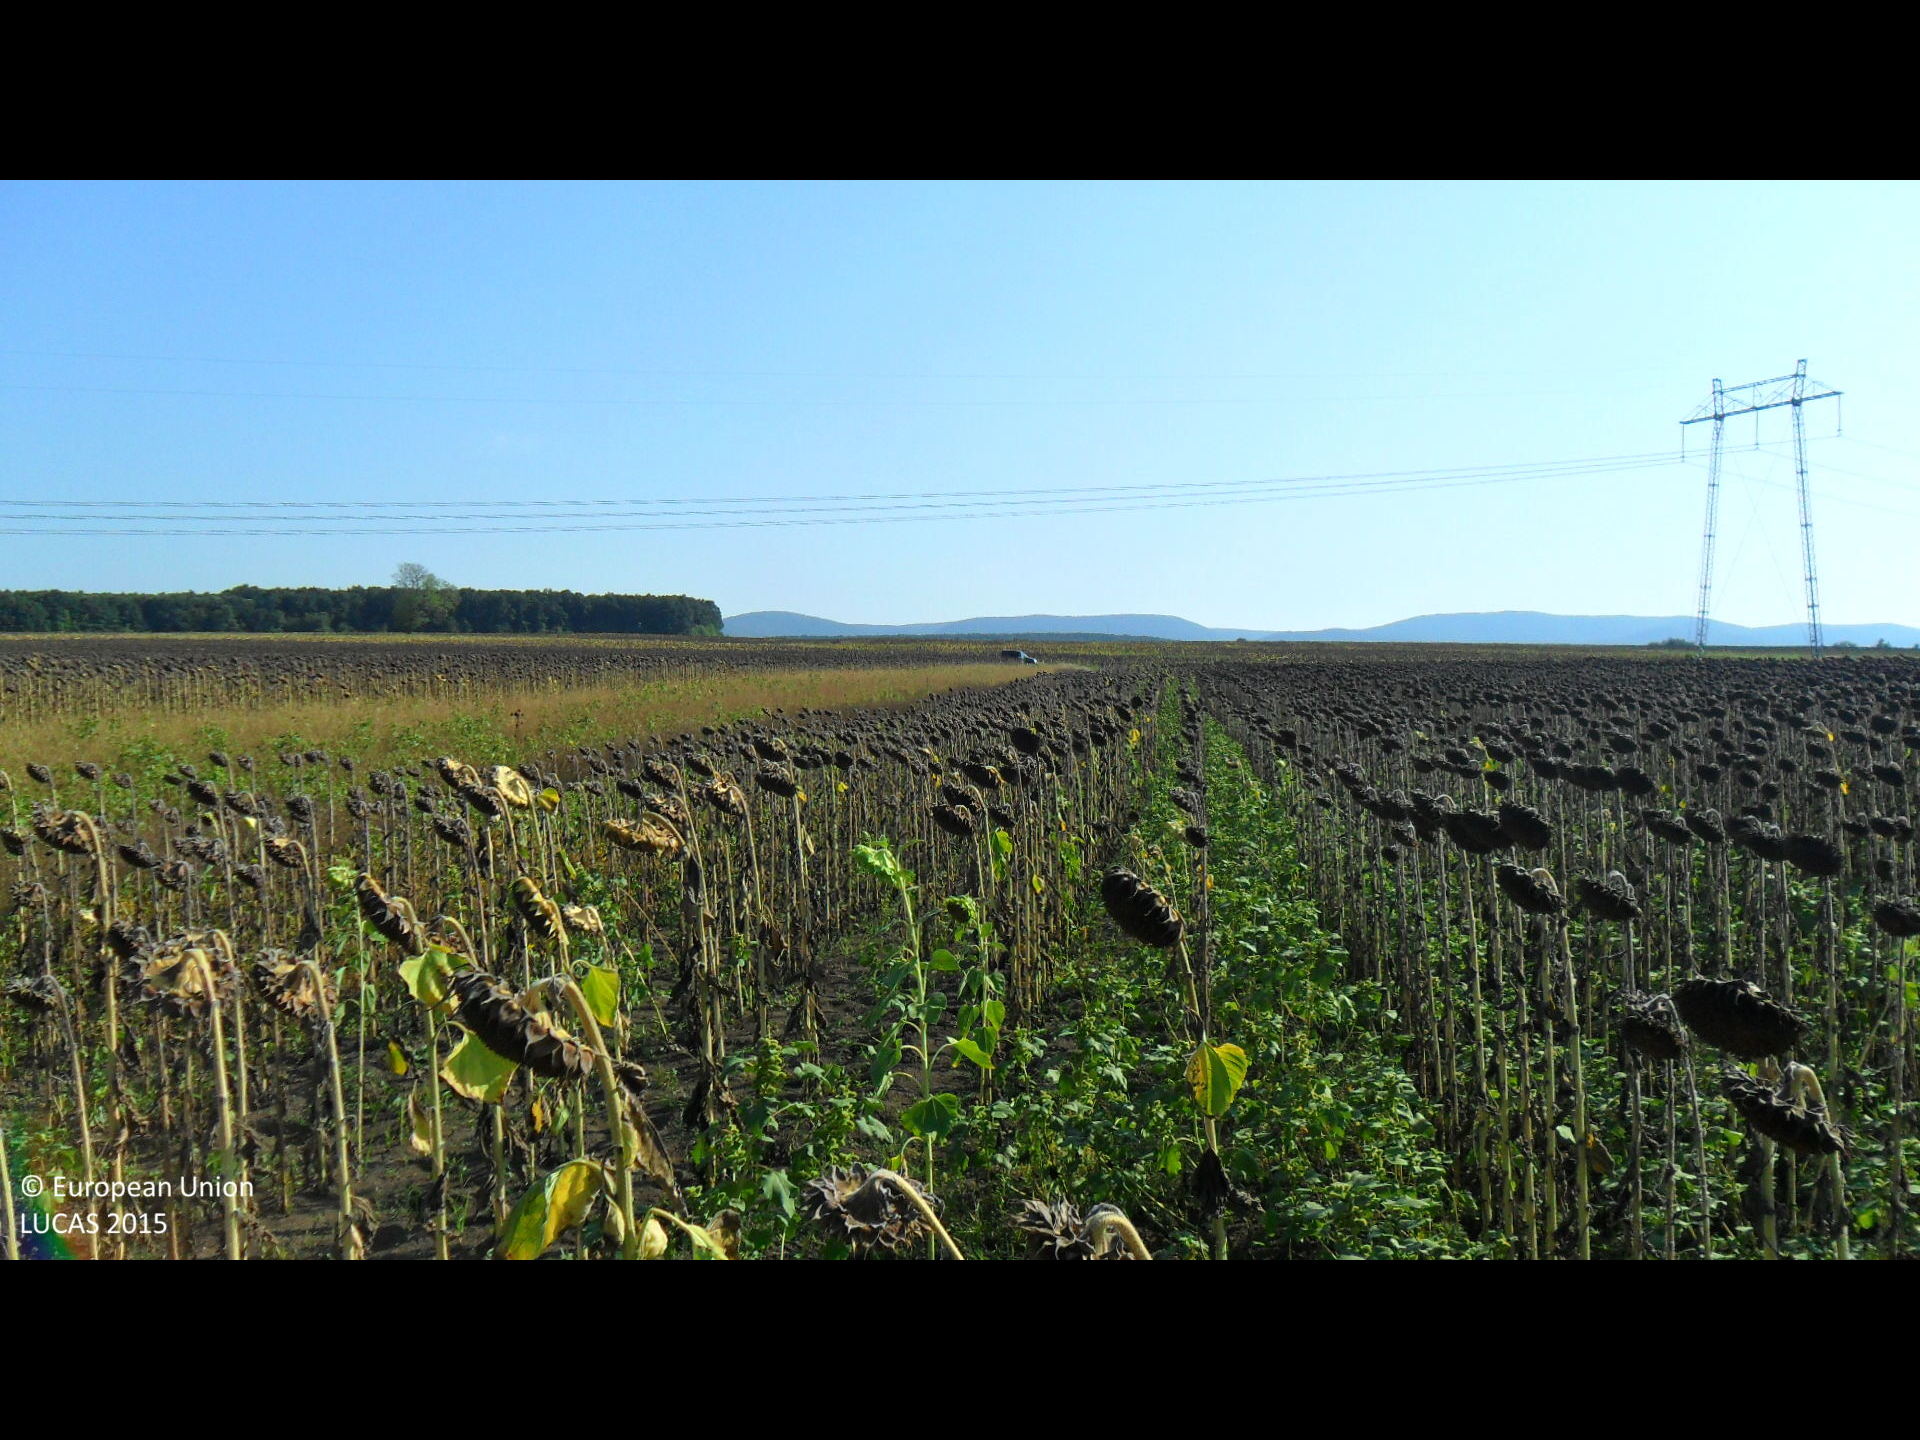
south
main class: Cropland
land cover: Sunflower
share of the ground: > 75 %
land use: Agriculture (excluding fallow land and kitchen gardens)
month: August
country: BG
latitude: 43.2342
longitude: 26.6422
